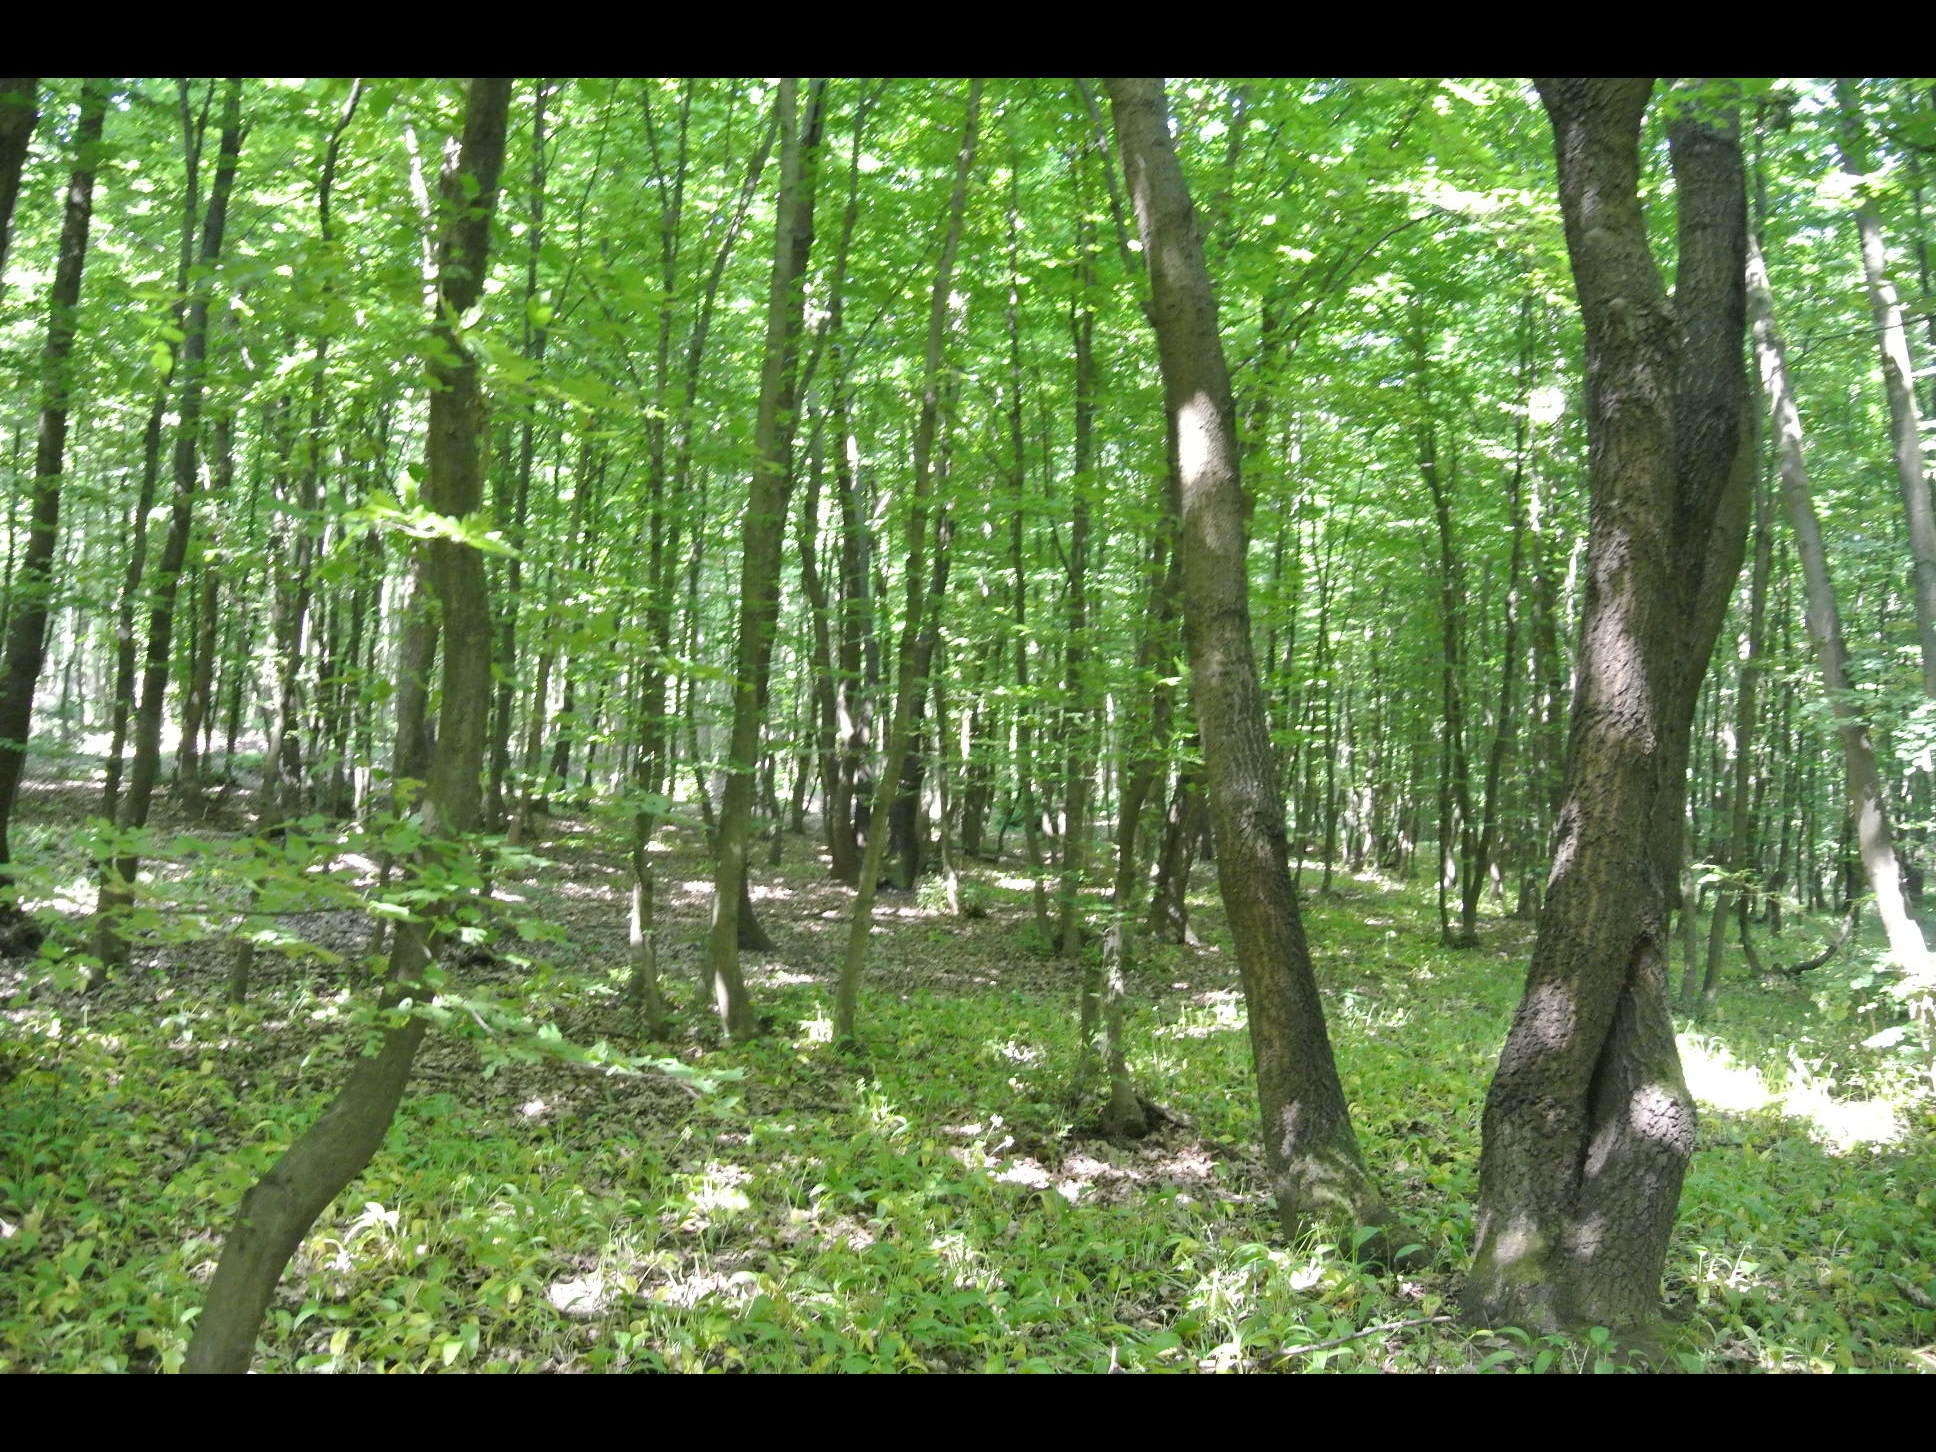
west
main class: Woodland
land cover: Broadleaved woodland
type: mesophytic deciduous forest
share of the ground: > 75 %
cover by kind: broadleaved forest trees 100 %
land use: Forestry
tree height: > 5 m
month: June
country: AT
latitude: 47.9057
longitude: 16.4932
